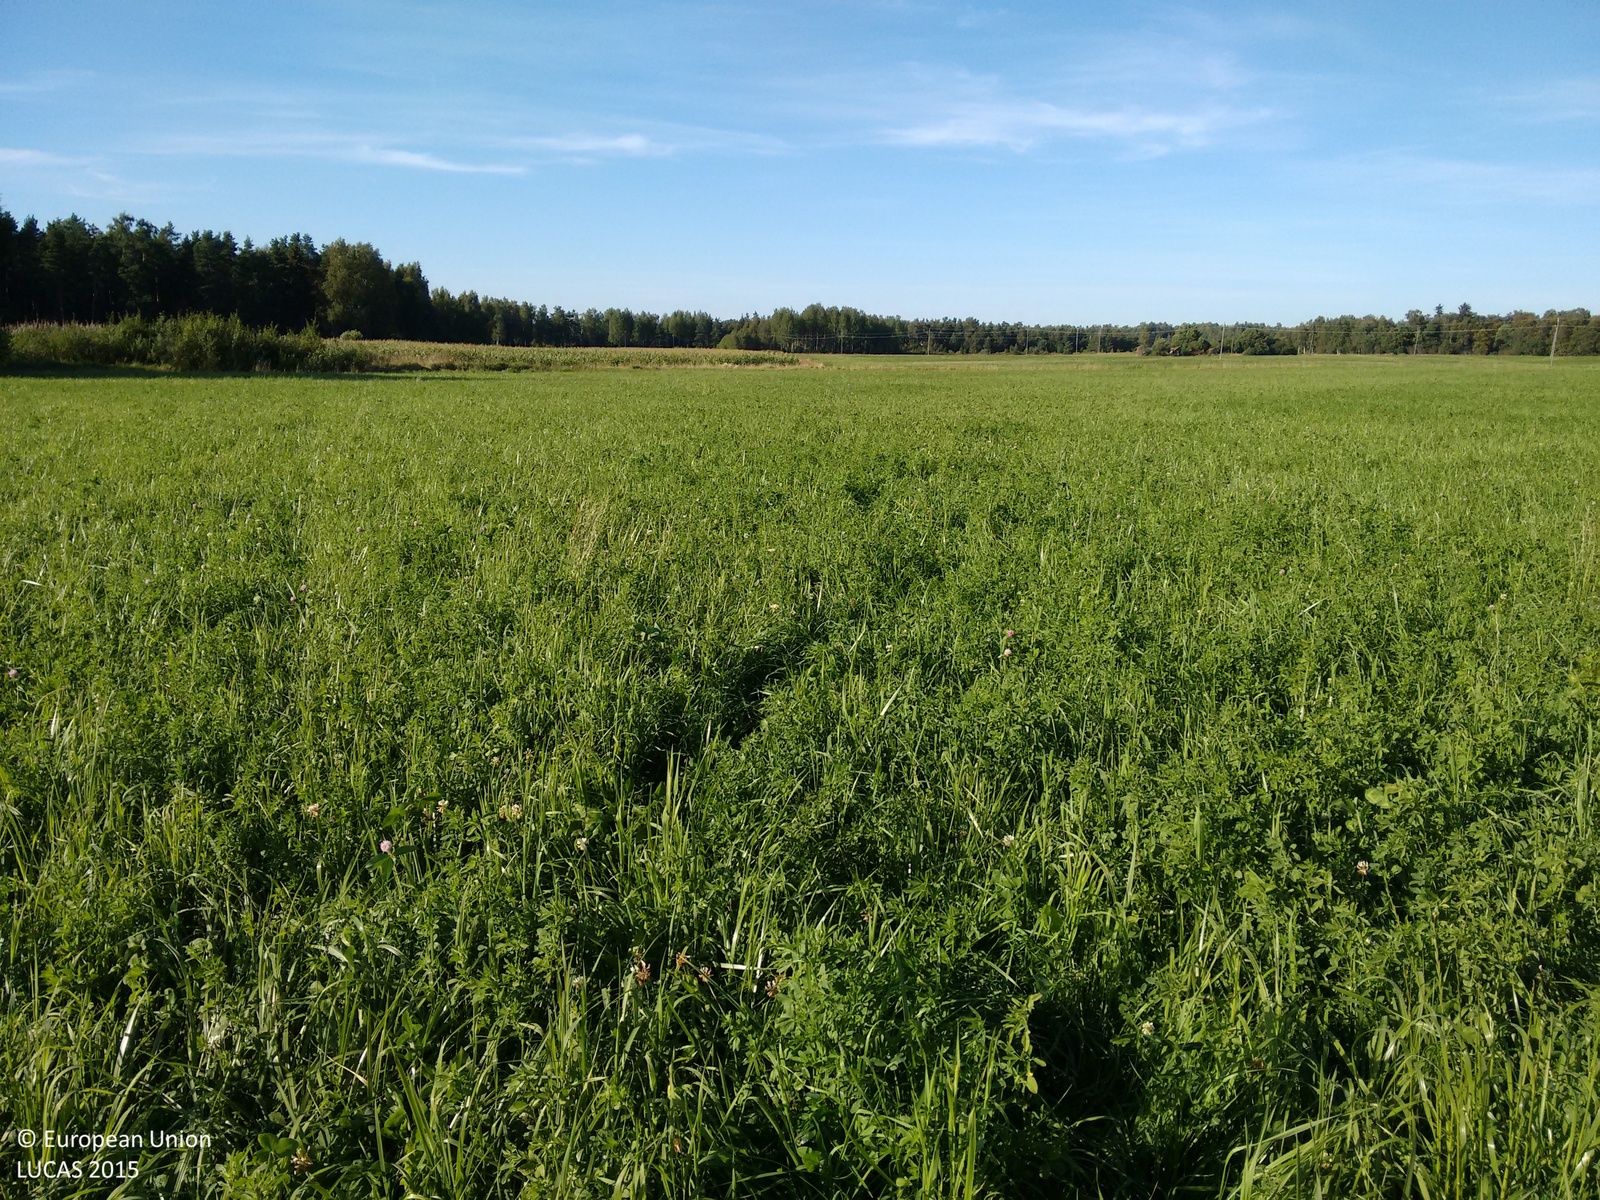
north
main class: Cropland
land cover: Temporary grasslands
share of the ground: > 75 %
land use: Agriculture (excluding fallow land and kitchen gardens)
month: August
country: FI
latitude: 60.1944
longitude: 19.9079
